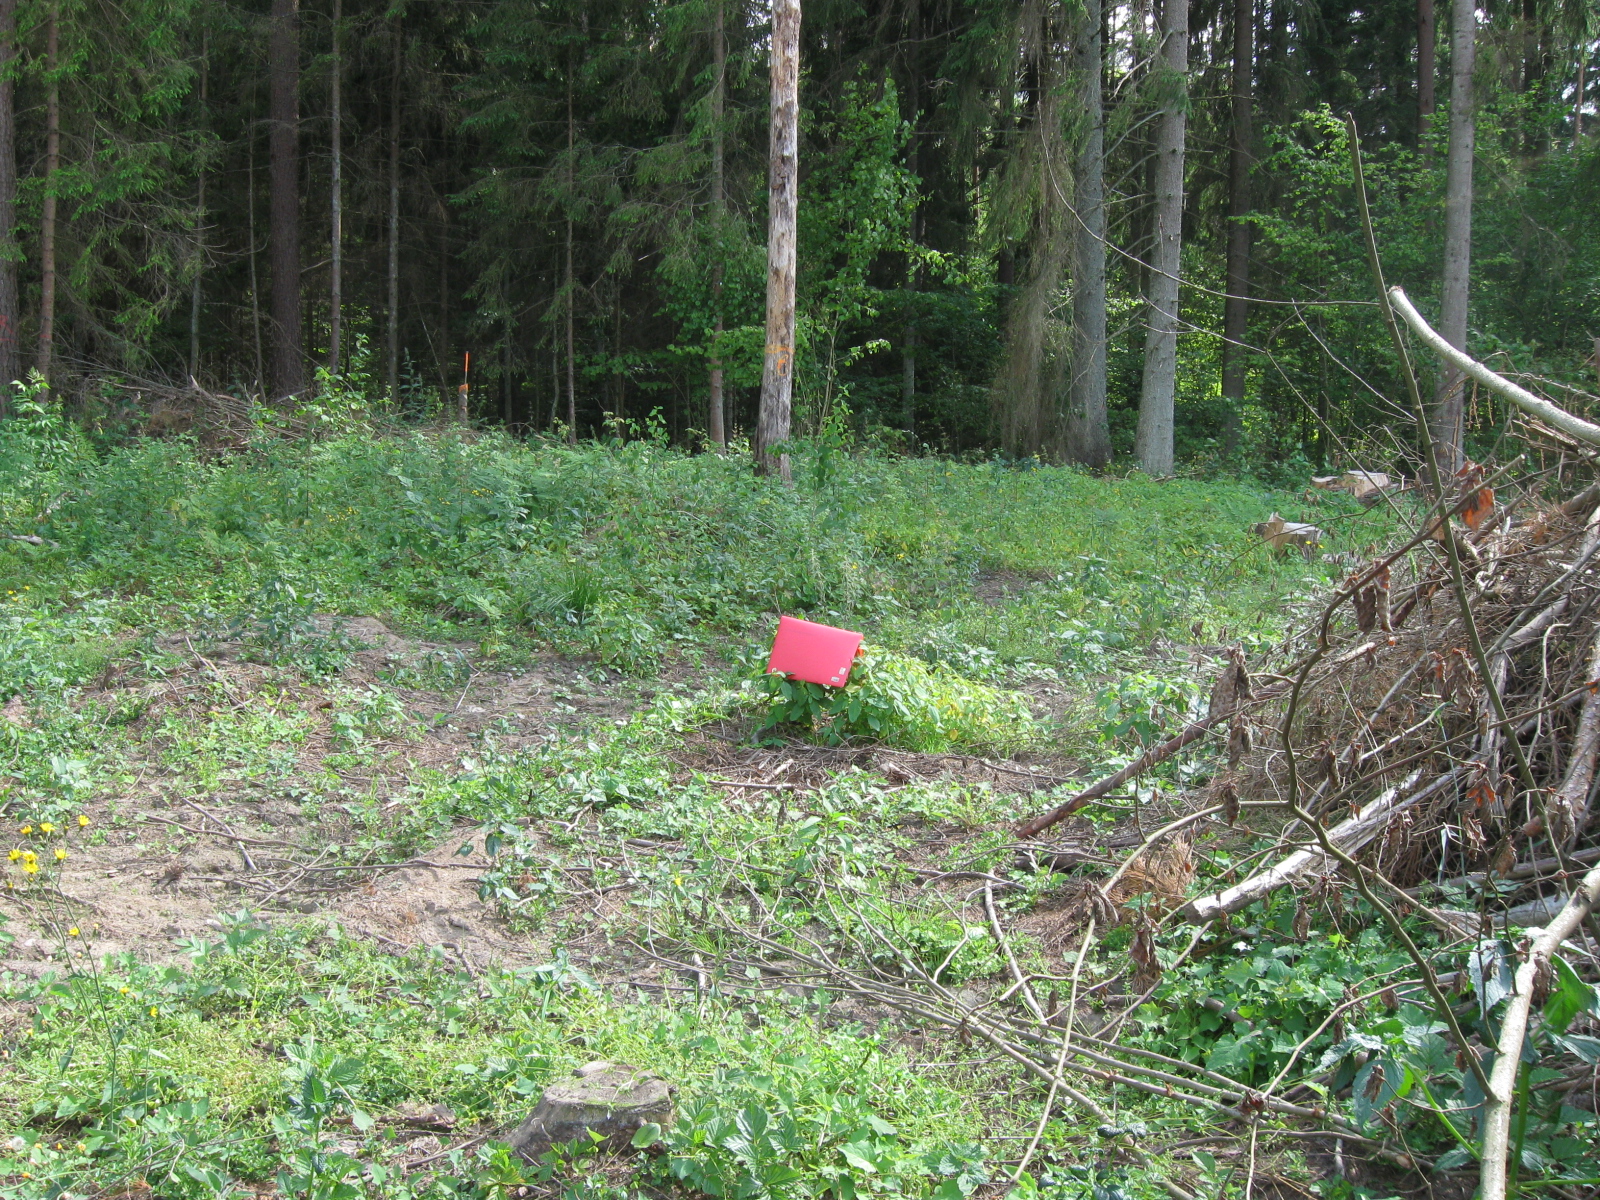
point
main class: Grassland
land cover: Spontaneously vegetated surfaces
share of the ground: > 75 %
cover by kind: herbaceous plants 75 %, unconsolidated bare surface 25 %
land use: Forestry
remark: Clear cut
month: July
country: LT
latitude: 54.2266
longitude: 24.3189
